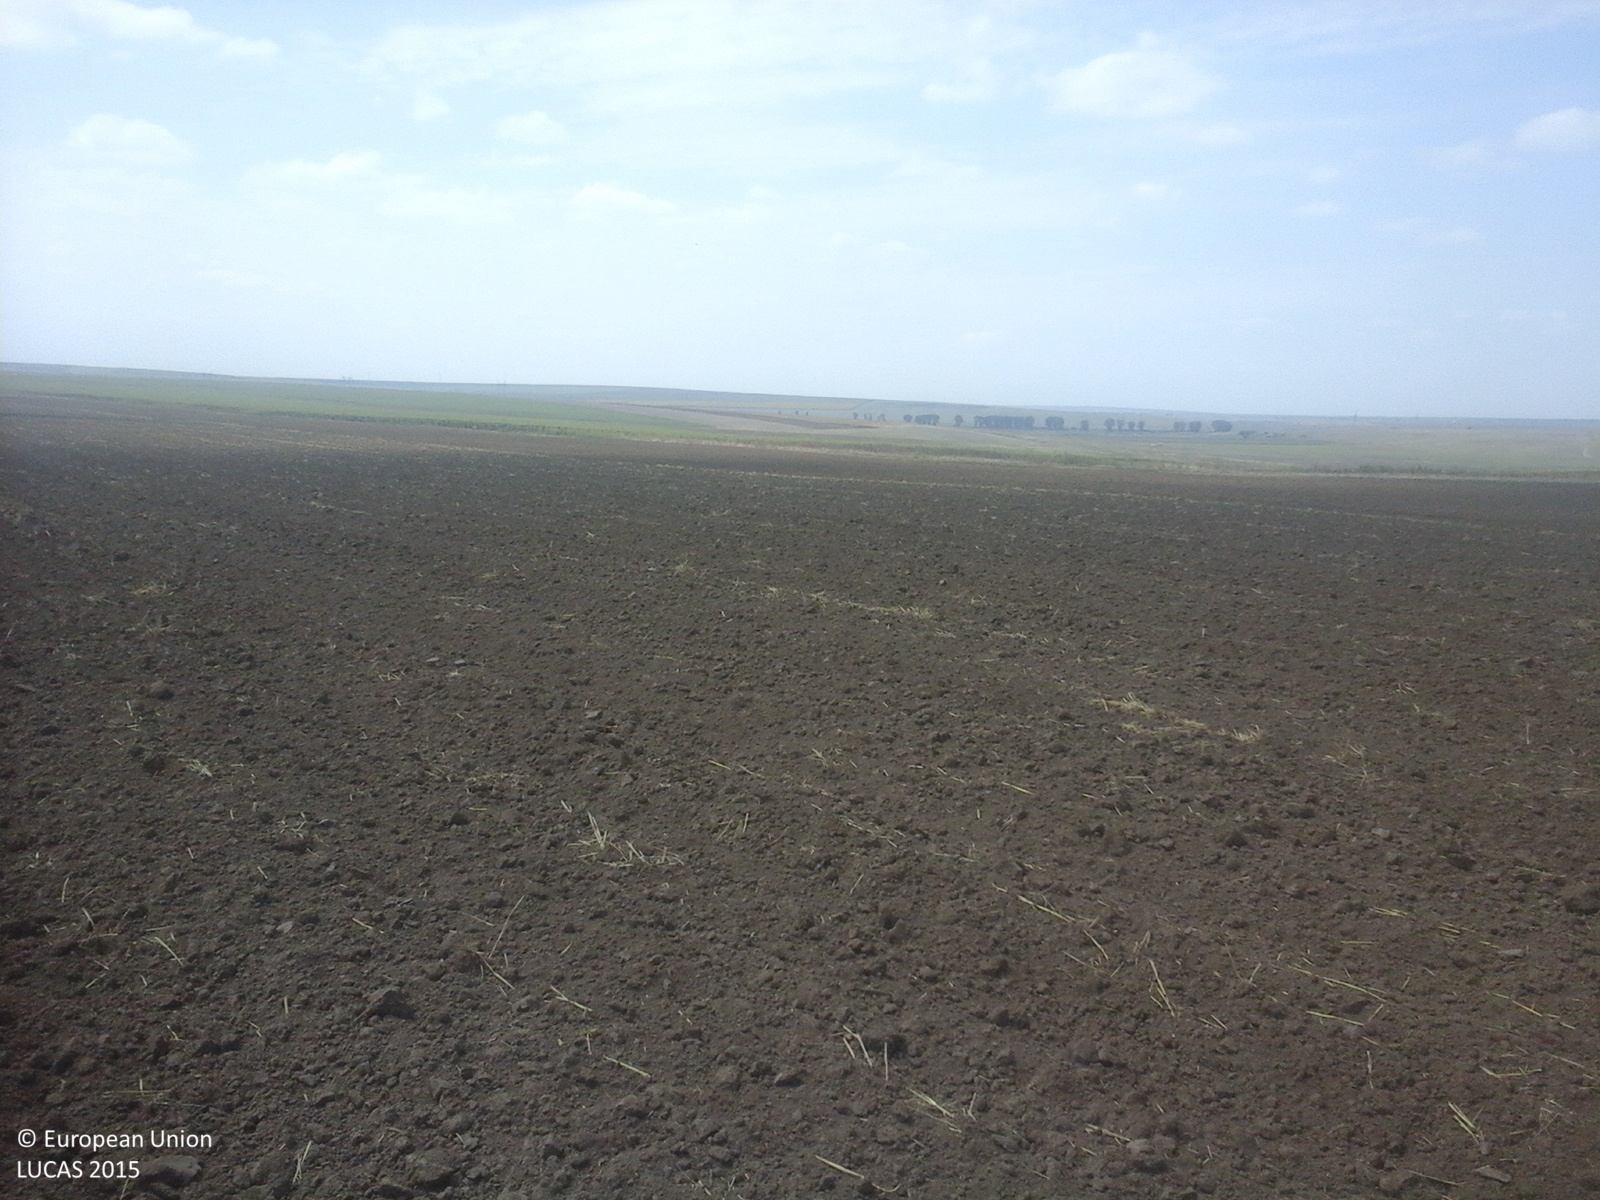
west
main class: Cropland
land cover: Common wheat
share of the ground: < 10 %
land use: Agriculture (excluding fallow land and kitchen gardens)
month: August
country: RO
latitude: 44.7248
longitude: 28.2611
